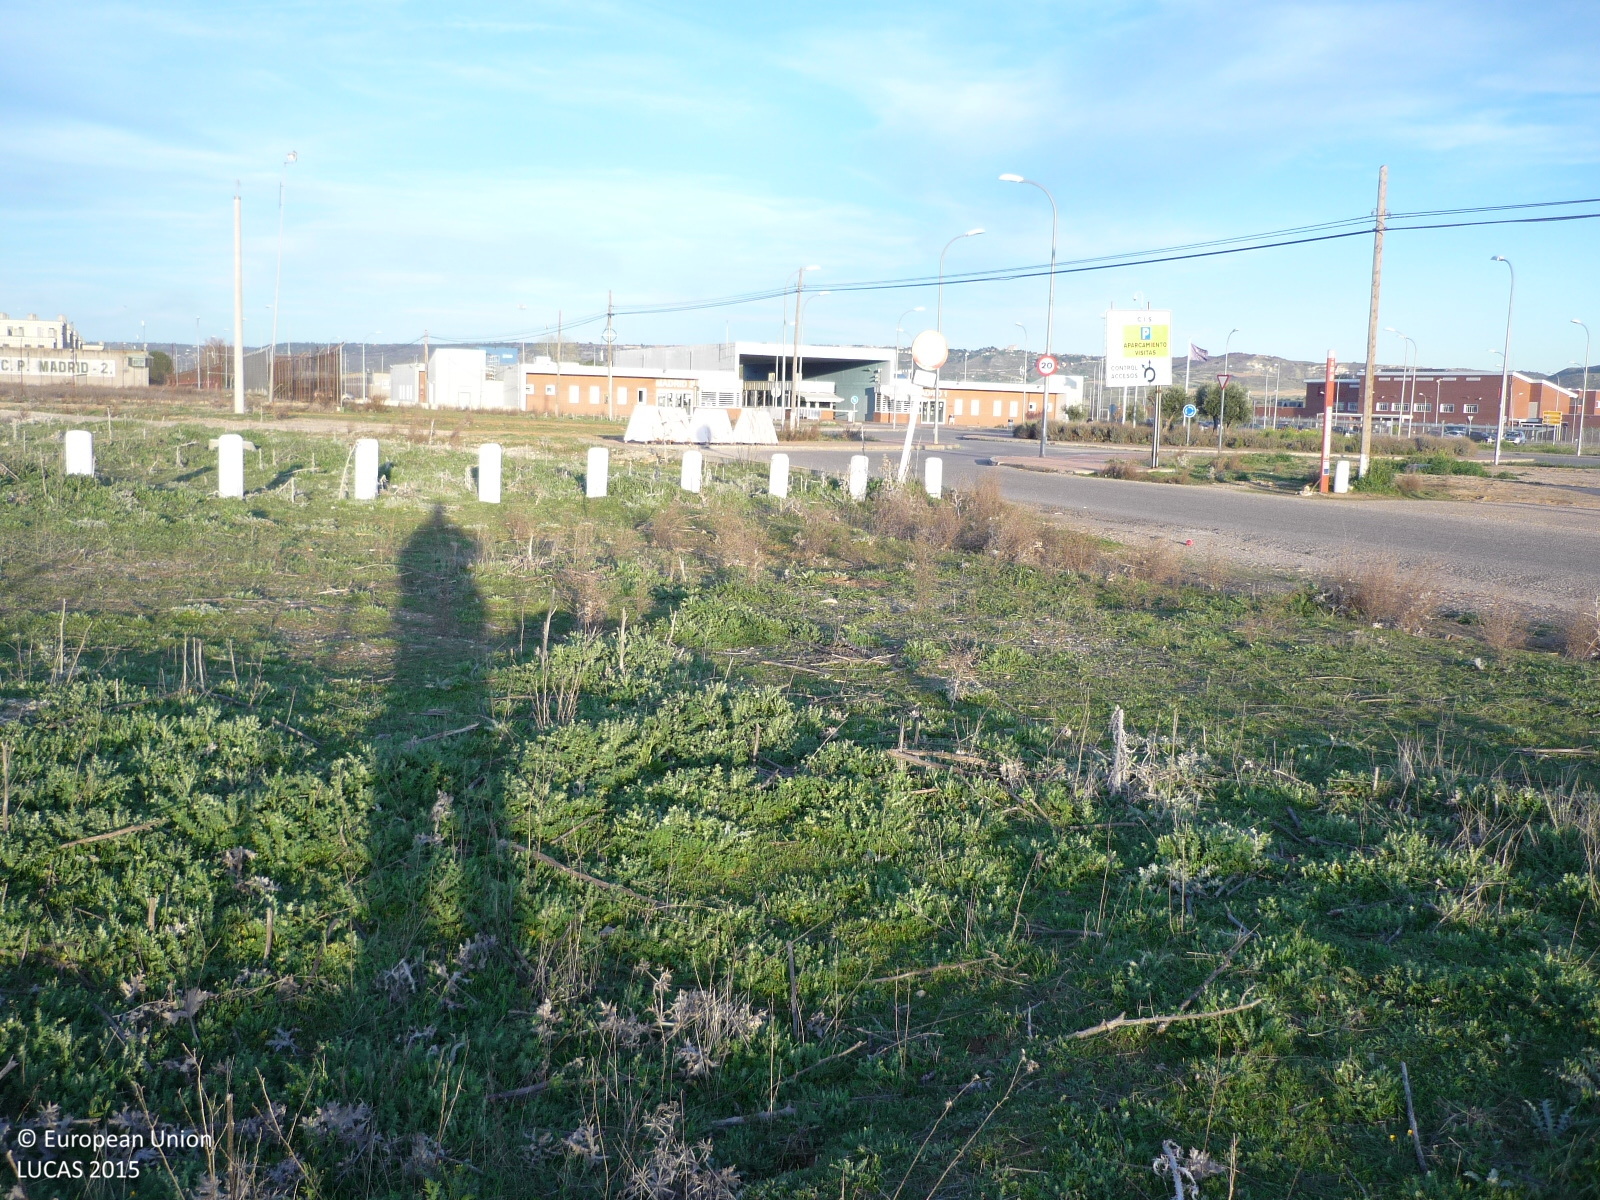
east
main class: Grassland
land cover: Grassland without tree/shrub cover
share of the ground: > 75 %
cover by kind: herbaceous plants 100 %
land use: Semi-natural and natural areas not in use
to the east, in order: Grassland without tree/shrub cover
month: March
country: ES
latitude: 40.5239
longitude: -3.3372
